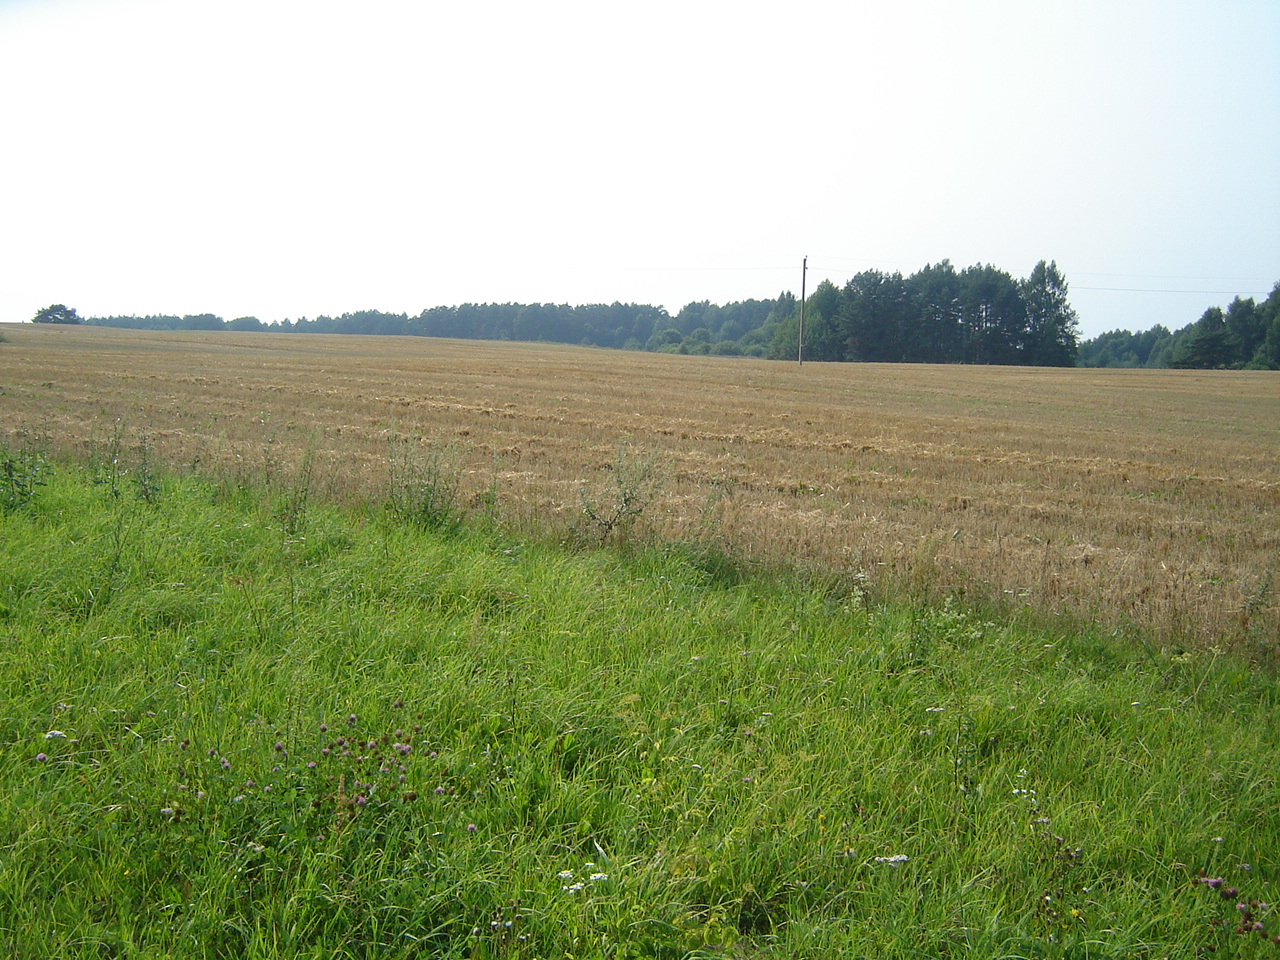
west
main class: Grassland
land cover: Grassland without tree/shrub cover
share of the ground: > 75 %
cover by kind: herbaceous plants 100 %
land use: Agriculture (excluding fallow land and kitchen gardens)
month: August
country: LT
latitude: 54.8960
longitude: 24.8451
